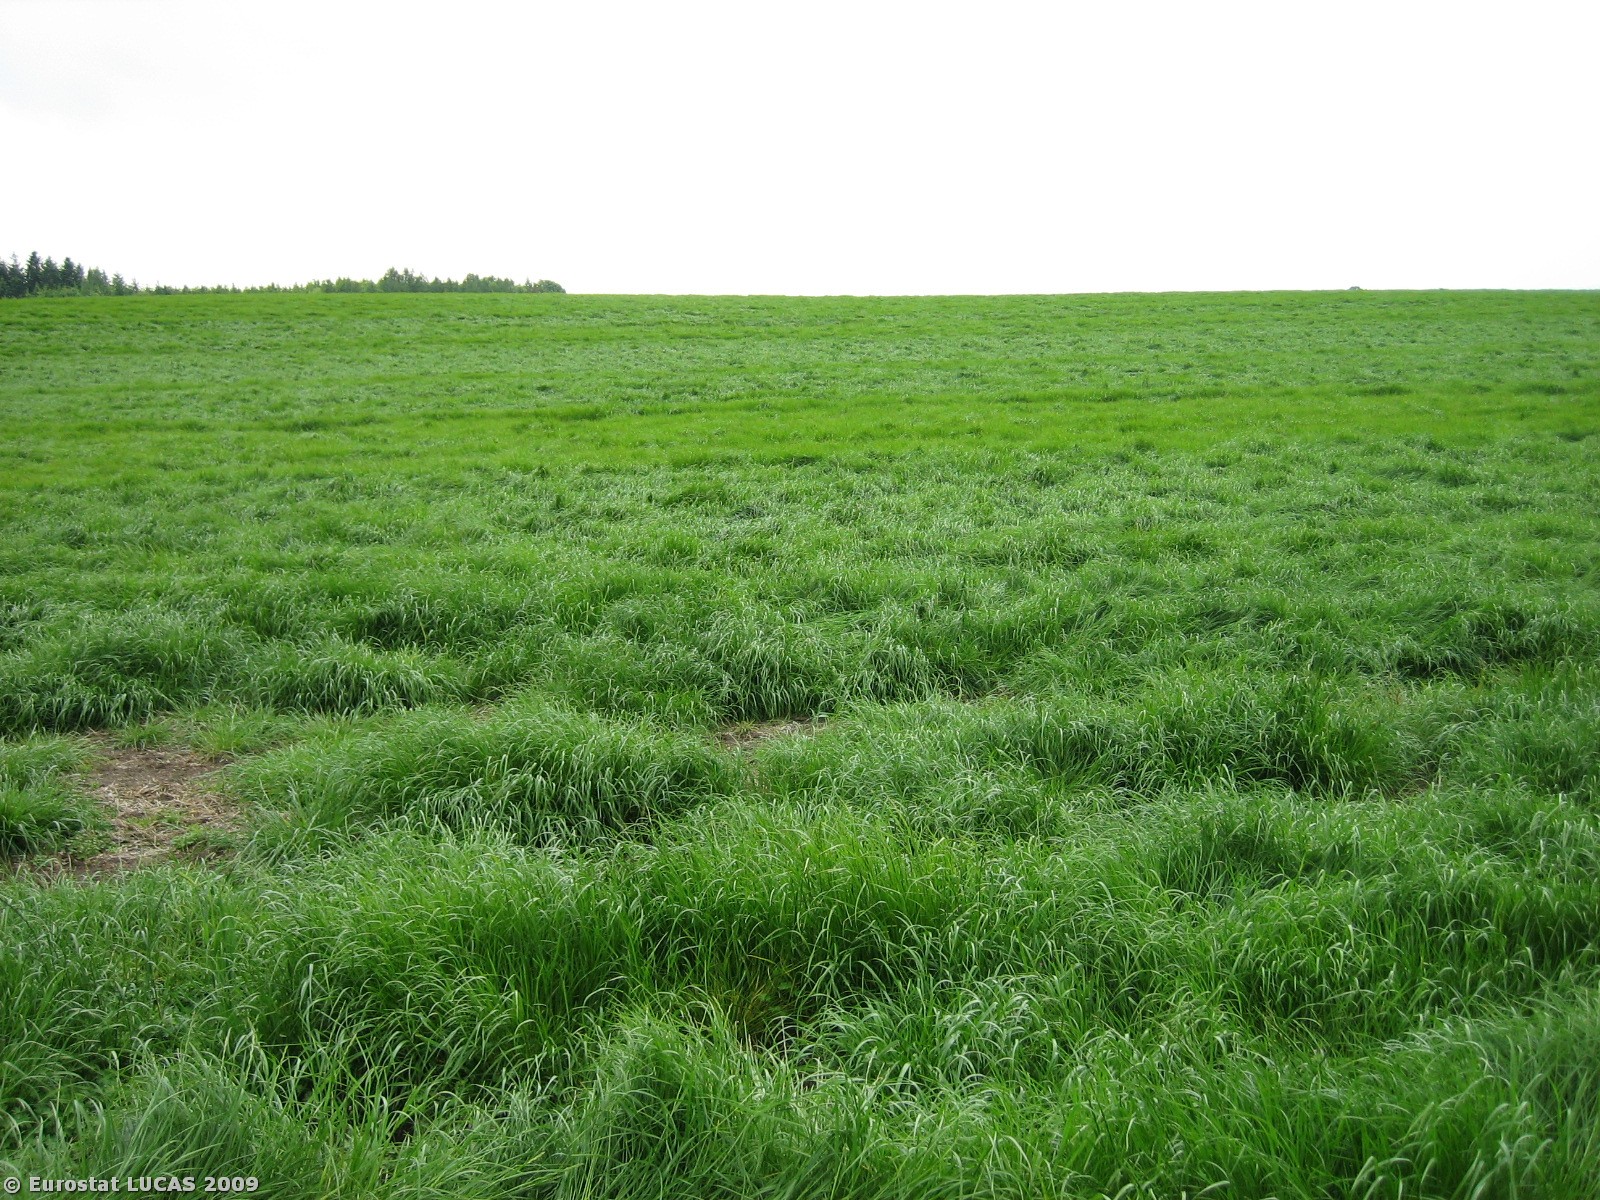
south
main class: Grassland
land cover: Grassland without tree/shrub cover
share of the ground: > 75 %
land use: Agriculture (excluding fallow land and kitchen gardens)
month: May
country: DK
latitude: 55.8264
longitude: 9.3143
